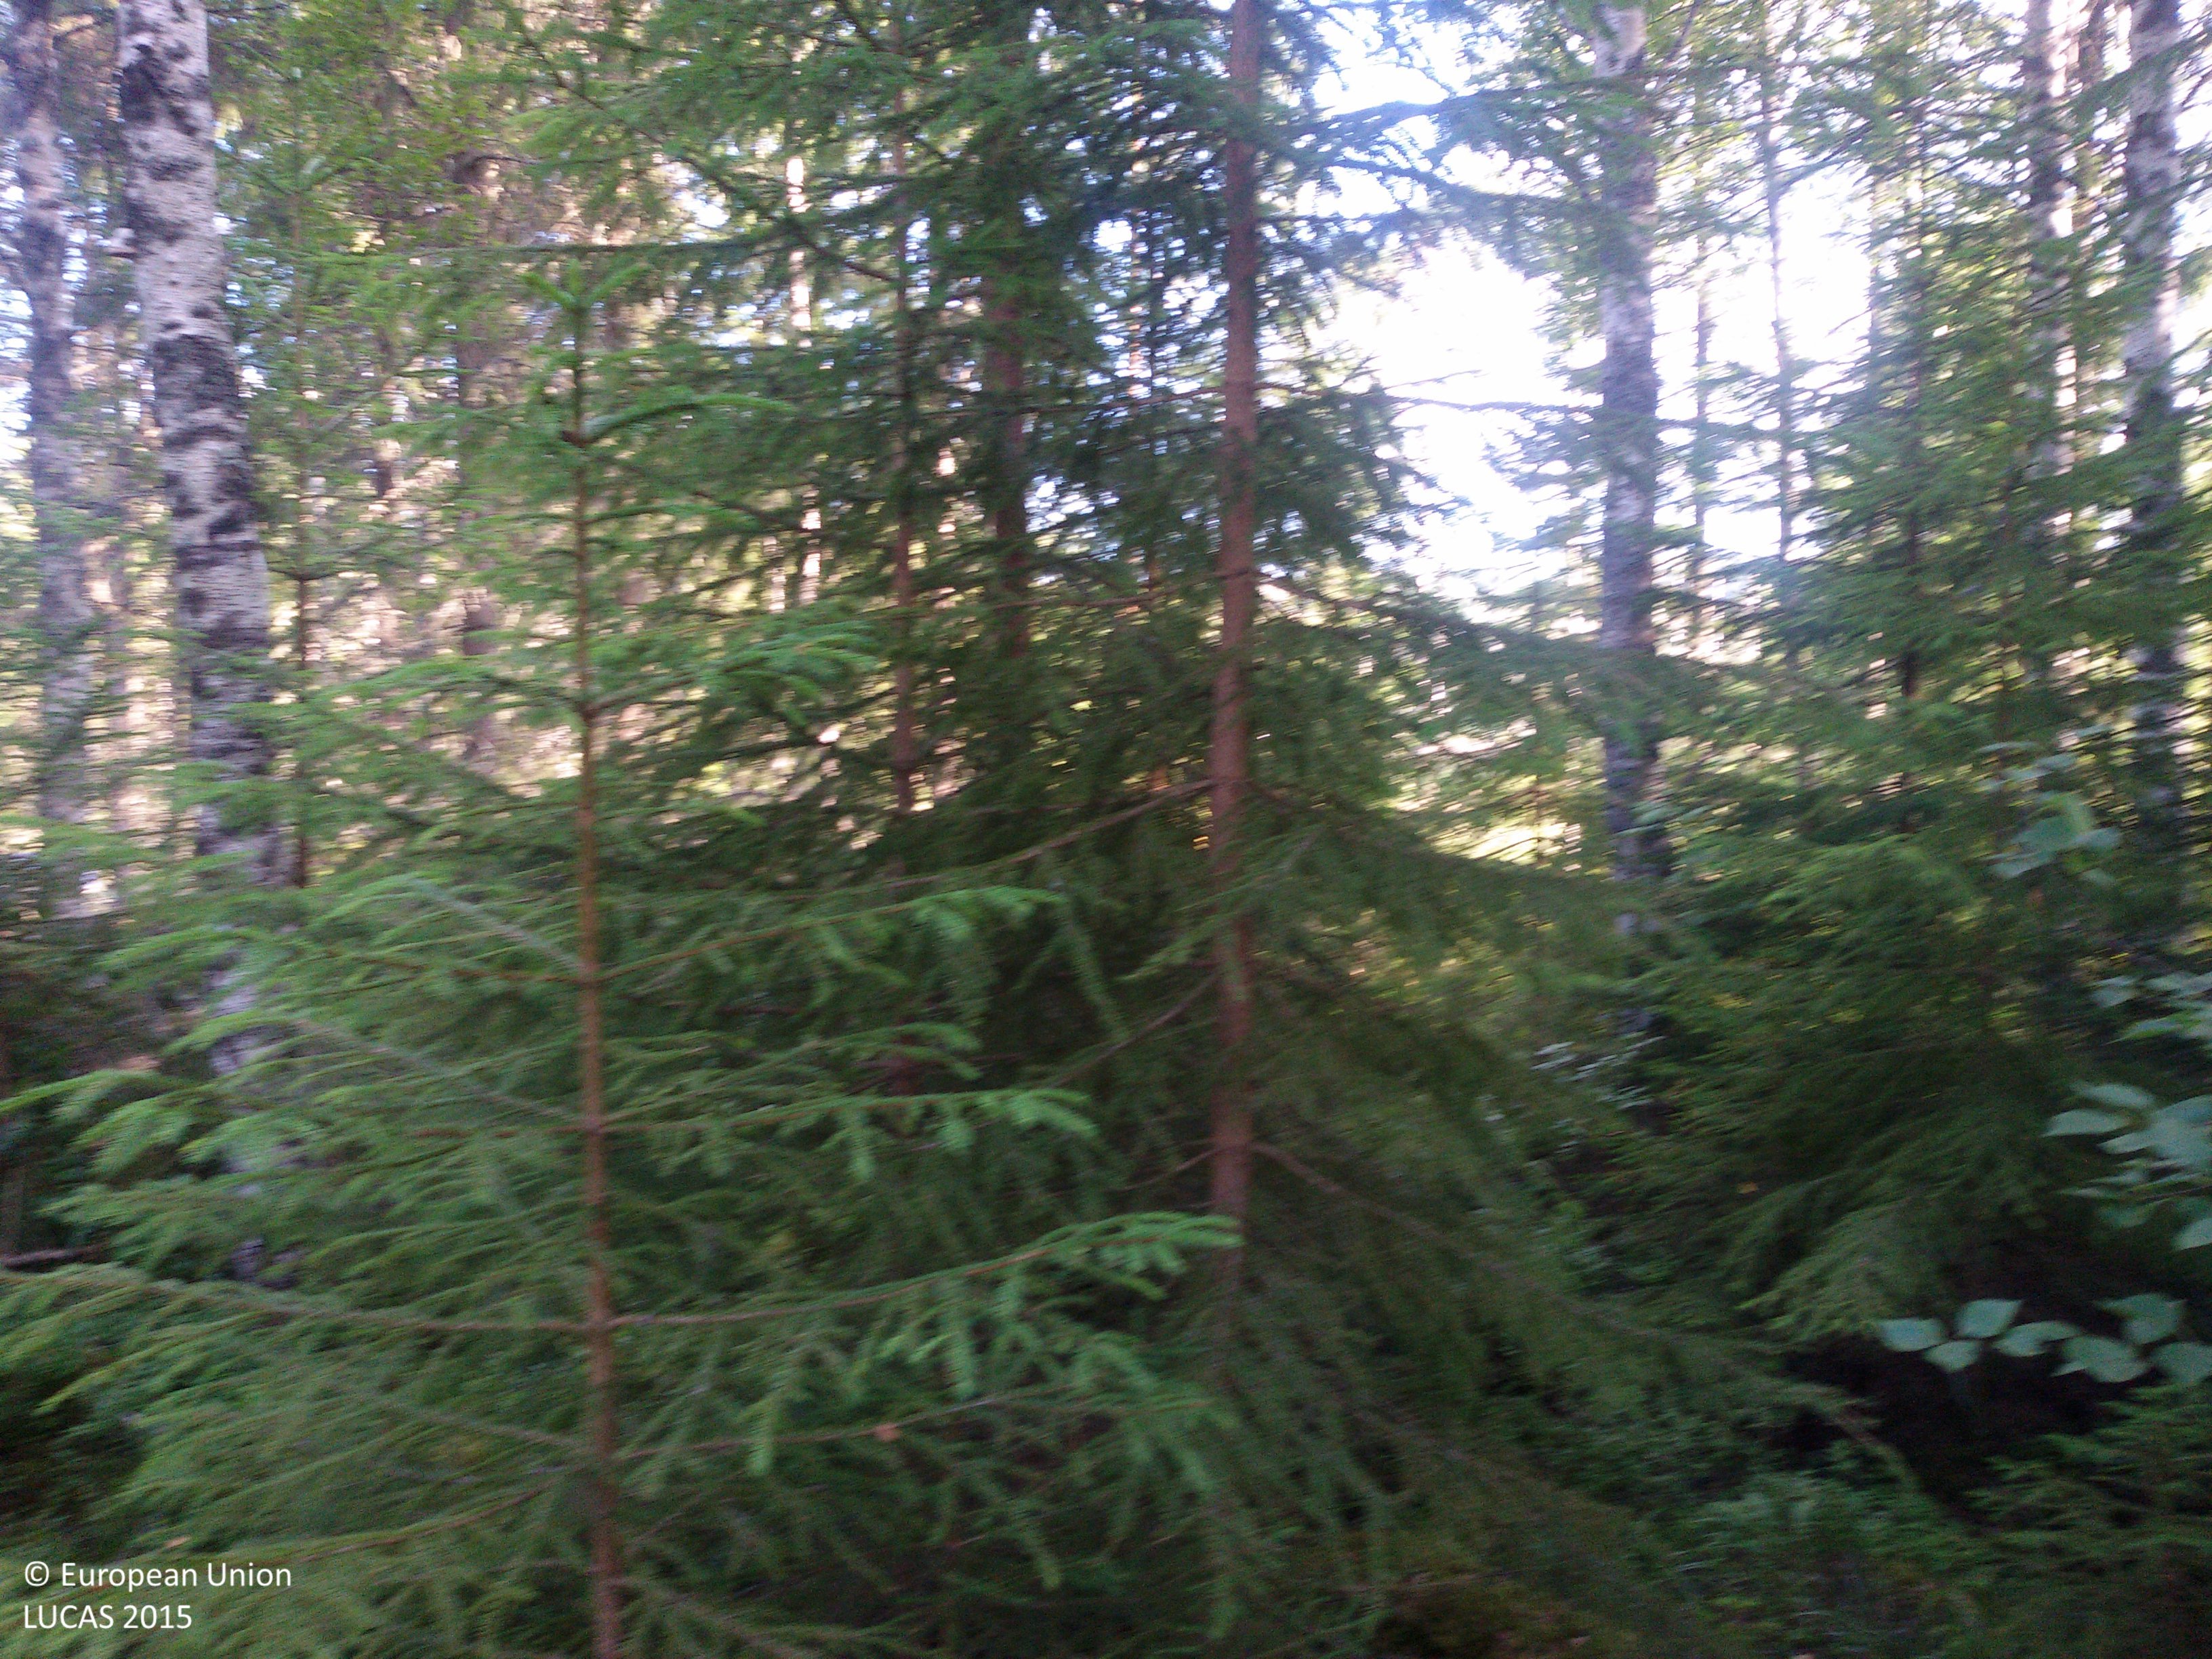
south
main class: Woodland
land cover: Spruce dominated mixed woodland
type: boreal forest
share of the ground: > 75 %
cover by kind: coniferous forest trees 40 %, broadleaved forest trees 40 %, herbaceous plants 10 %, lichens and mosses 10 %
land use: Forestry
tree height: > 5 m
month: July
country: SE
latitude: 60.6735
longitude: 15.3866
